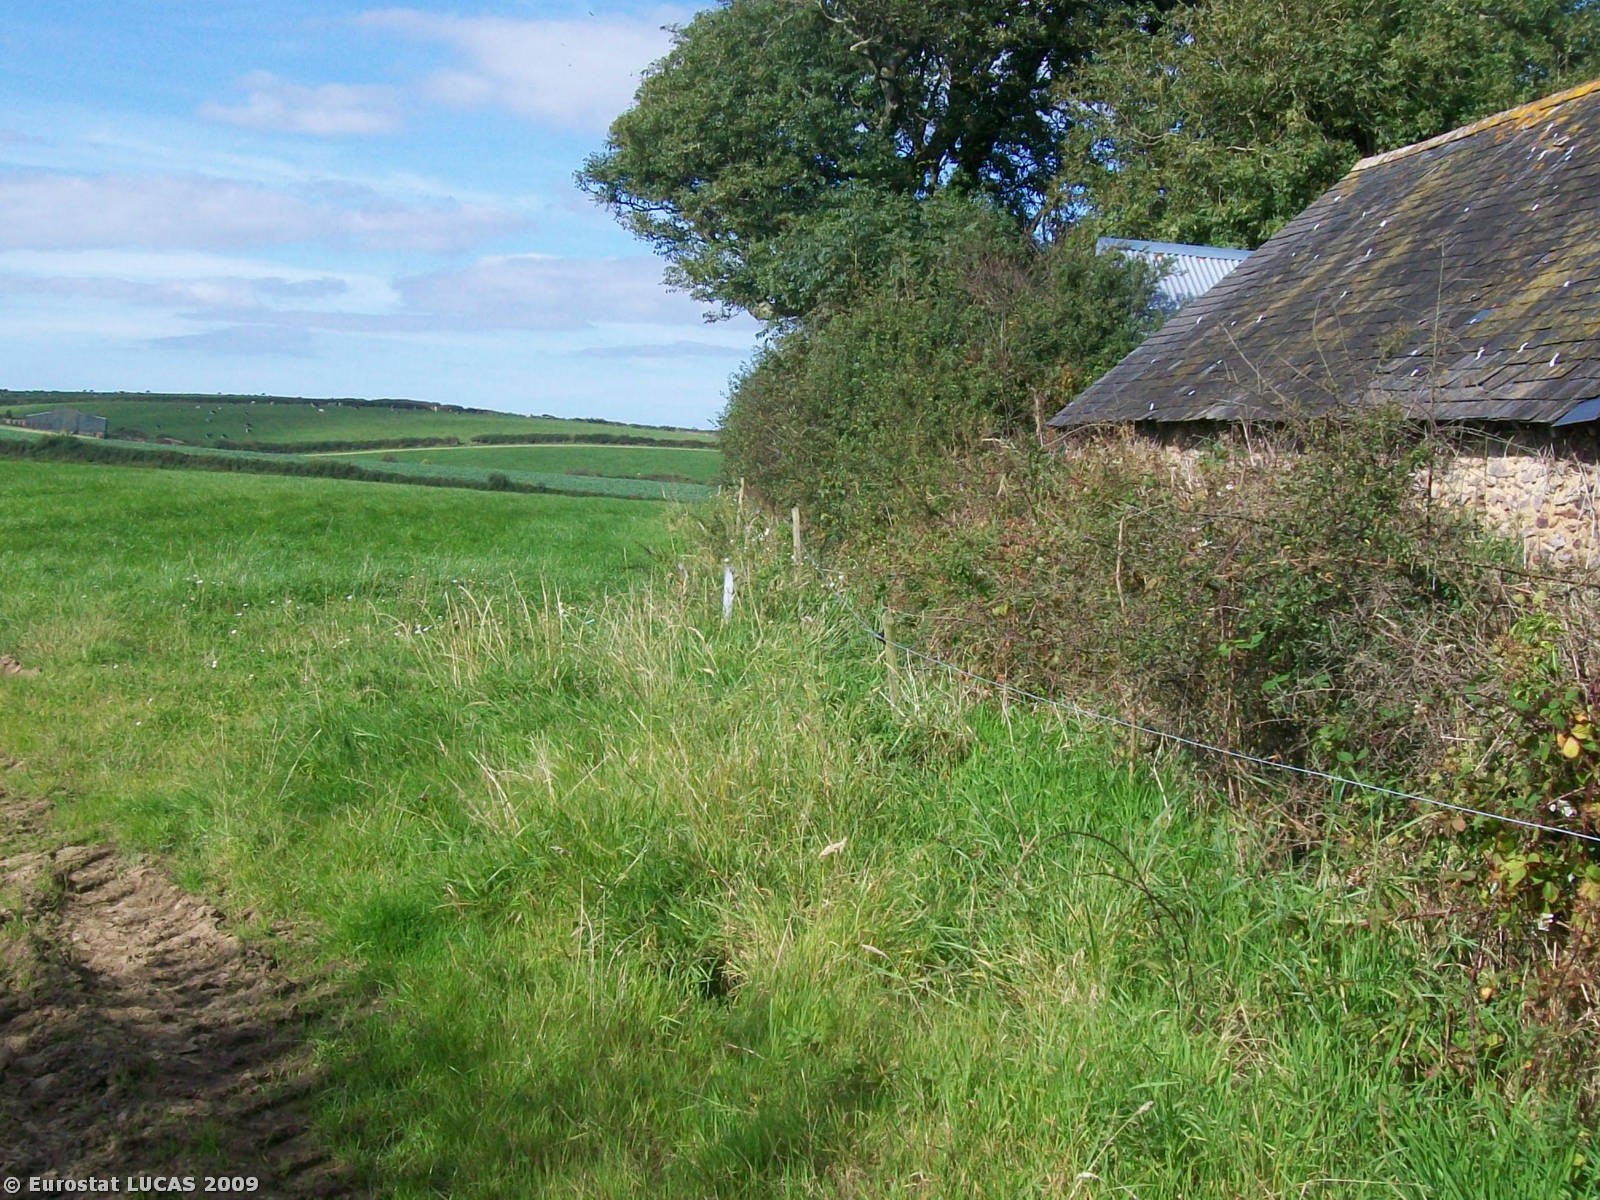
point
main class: Grassland
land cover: Grassland without tree/shrub cover
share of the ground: > 75 %
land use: Agriculture (excluding fallow land and kitchen gardens)
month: September
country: GB
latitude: 51.7435
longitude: -5.0206
